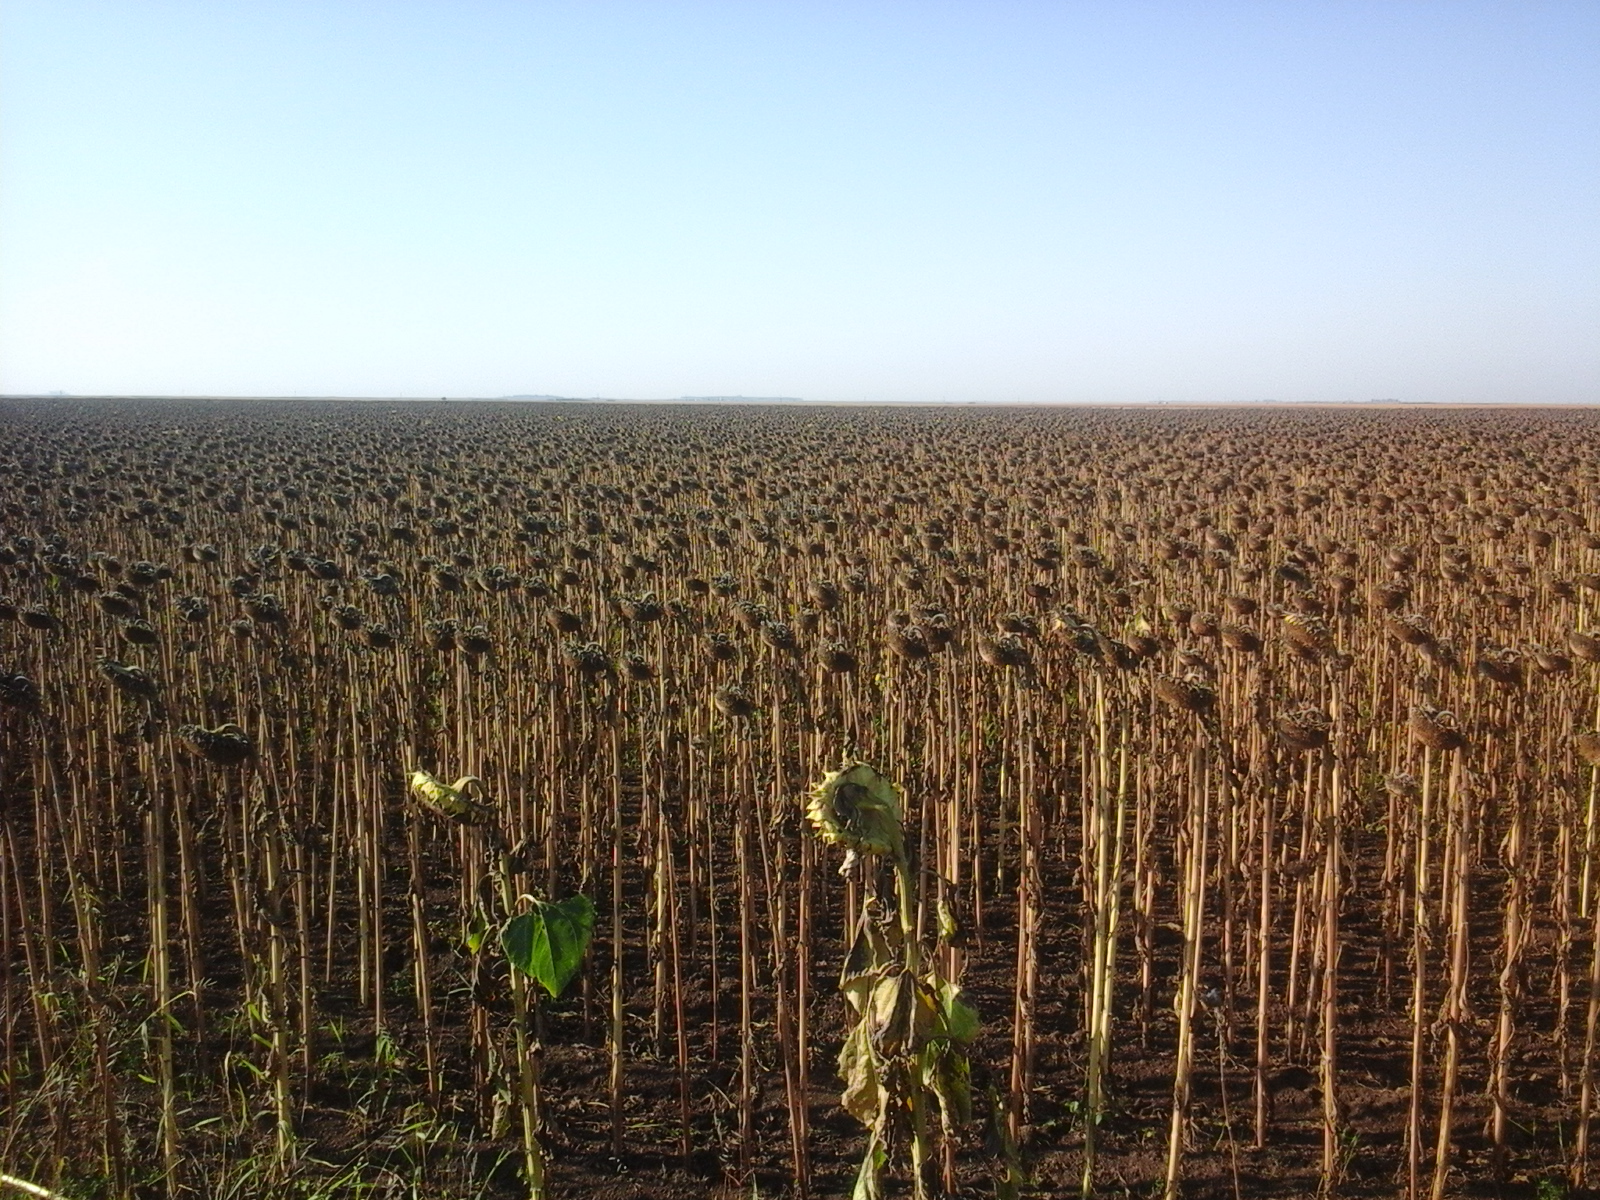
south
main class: Cropland
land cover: Sunflower
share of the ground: > 75 %
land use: Agriculture (excluding fallow land and kitchen gardens)
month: August
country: RO
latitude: 46.0258
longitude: 21.1017
